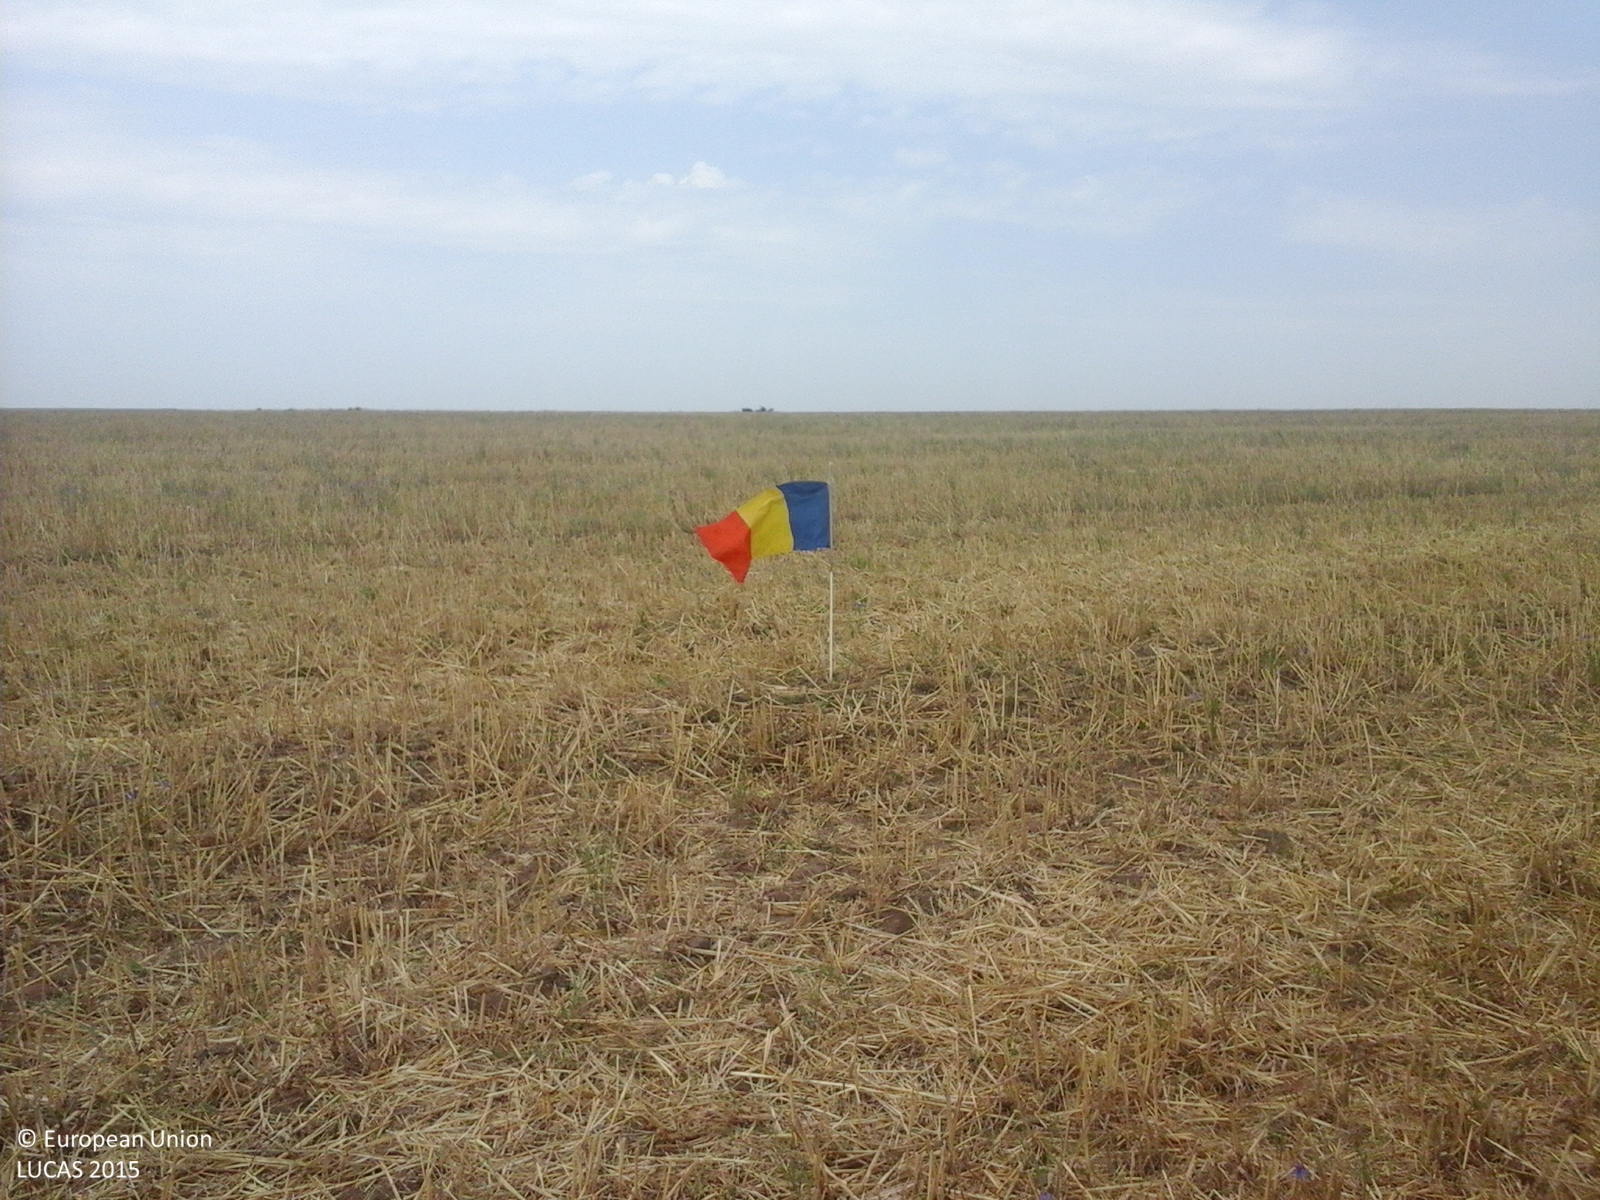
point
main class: Cropland
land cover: Common wheat
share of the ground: 25 - 50 %
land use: Agriculture (excluding fallow land and kitchen gardens)
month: August
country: RO
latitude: 43.9656
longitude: 27.7553
